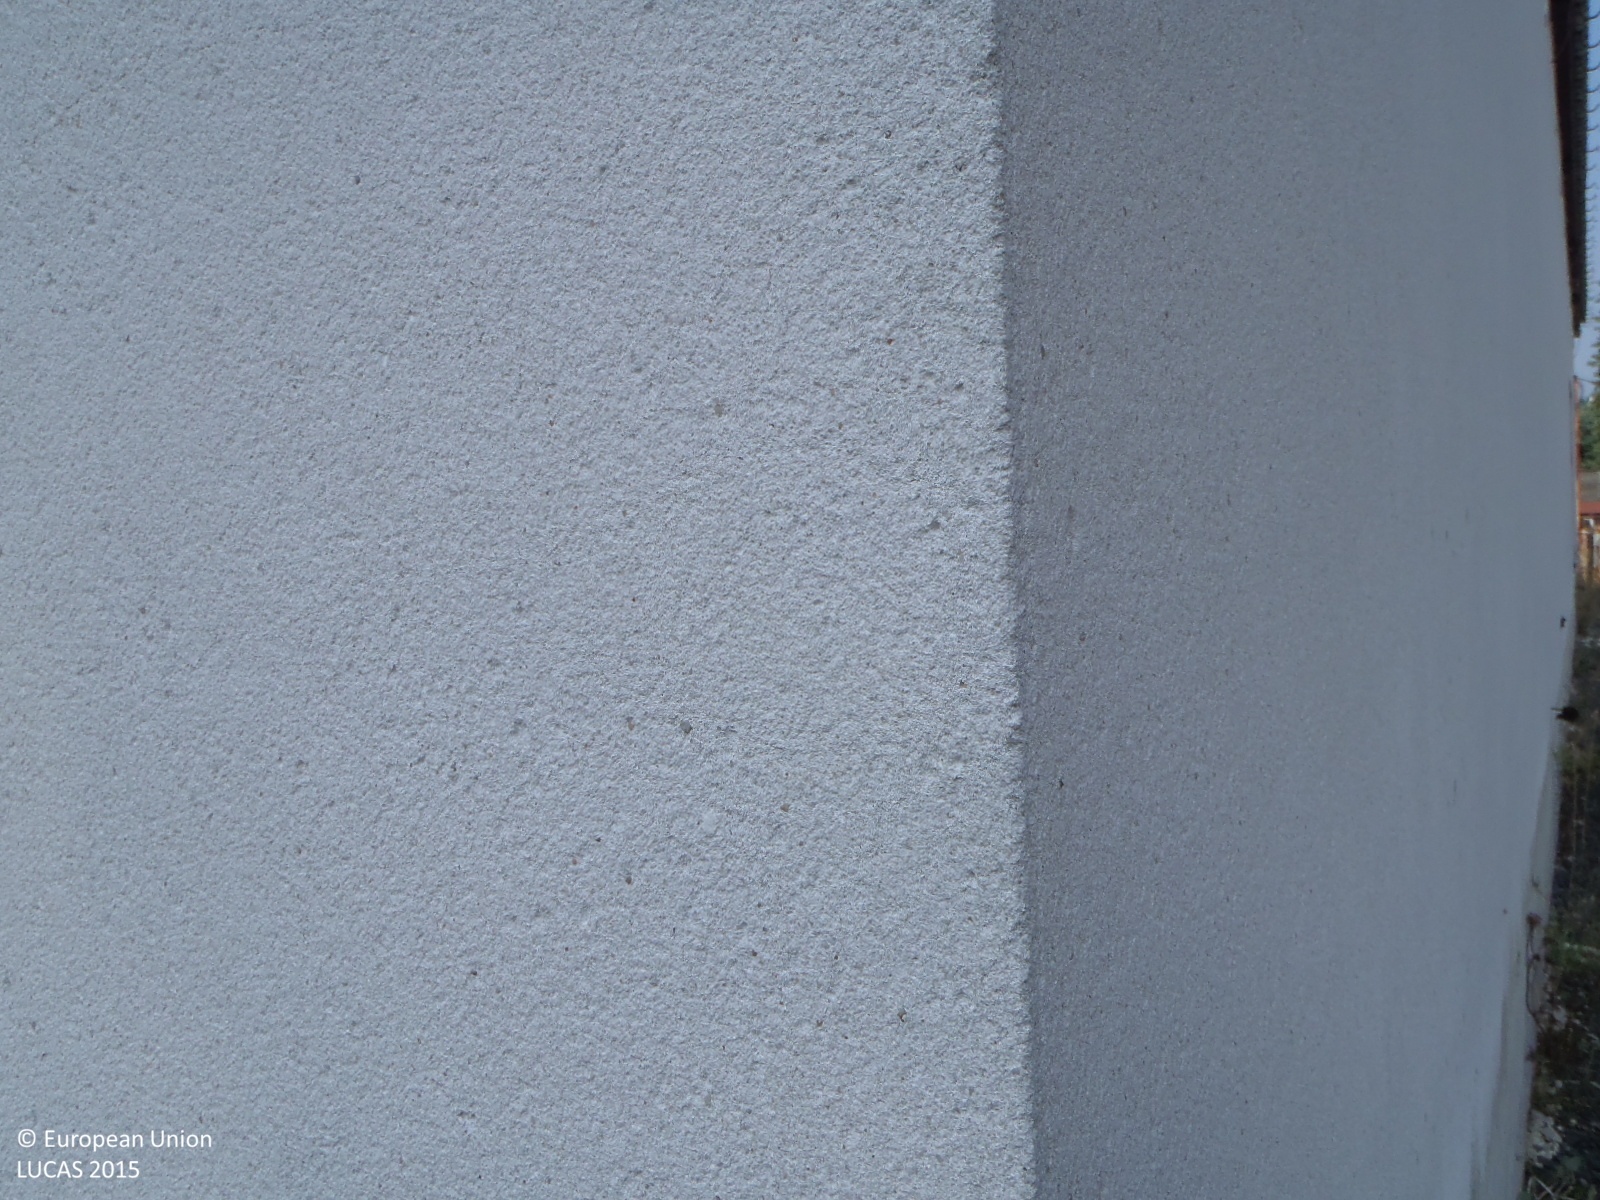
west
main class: Grassland
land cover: Spontaneously vegetated surfaces
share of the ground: > 75 %
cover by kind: herbaceous plants 100 %
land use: Coal, oil and metal processing
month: August
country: CZ
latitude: 50.7296
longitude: 15.2596
